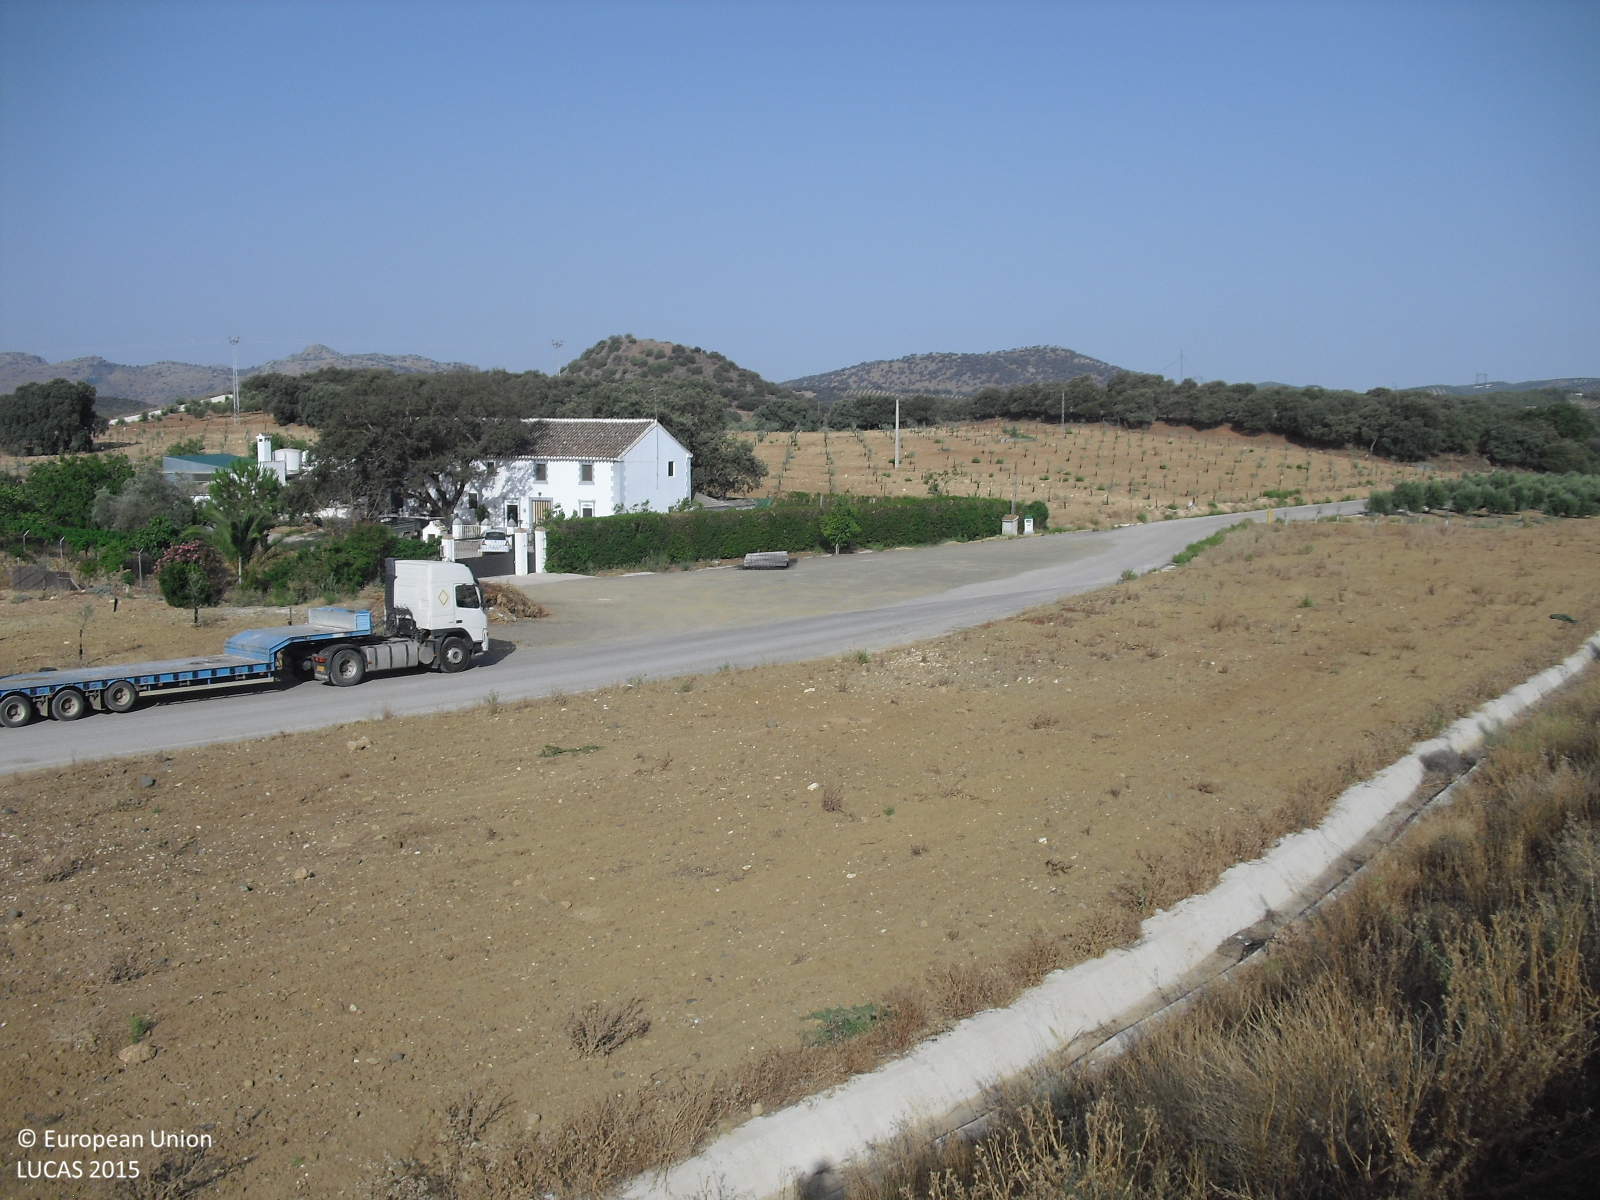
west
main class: Grassland
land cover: Grassland without tree/shrub cover
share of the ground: 25 - 50 %
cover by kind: unconsolidated bare surface 65 %, herbaceous plants 35 %
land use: Protection infrastructures
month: July
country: ES
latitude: 37.1381
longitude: -4.3040
